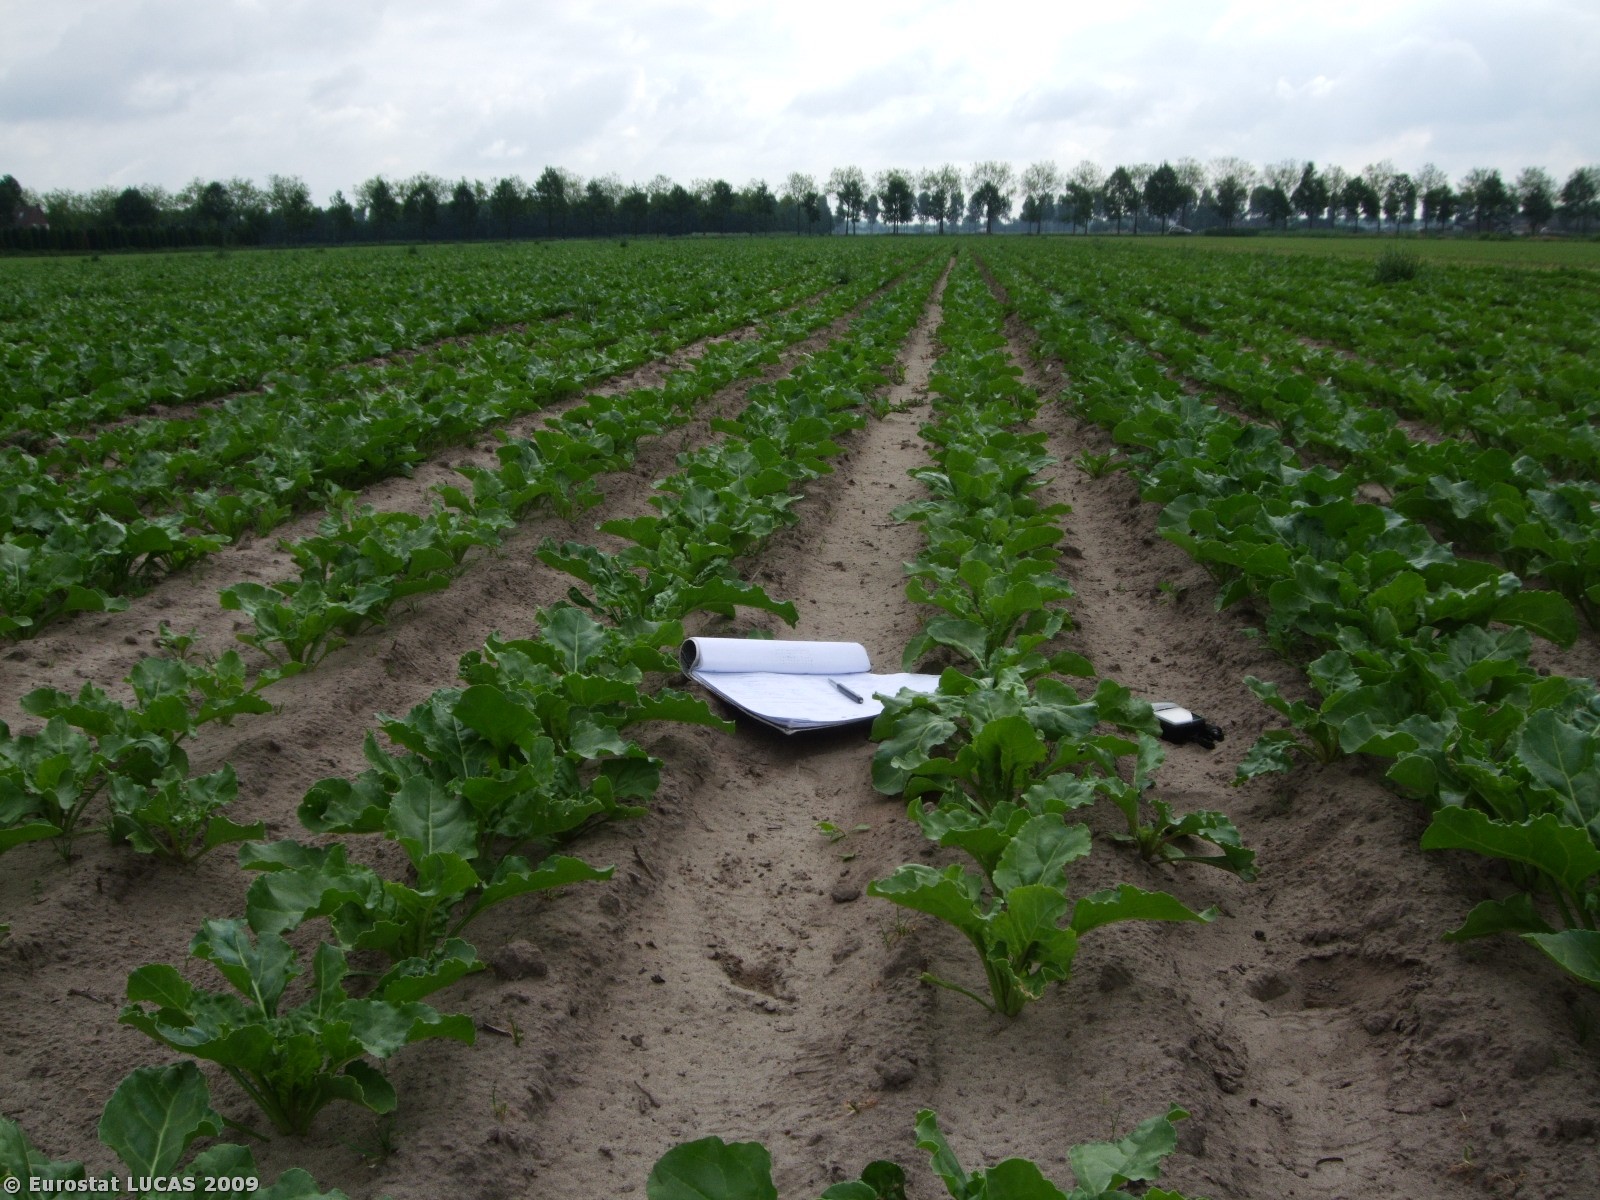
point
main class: Cropland
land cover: Sugar beet
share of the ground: 50 - 75 %
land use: Agriculture (excluding fallow land and kitchen gardens)
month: May
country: NL
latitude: 51.7137
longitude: 5.4390
